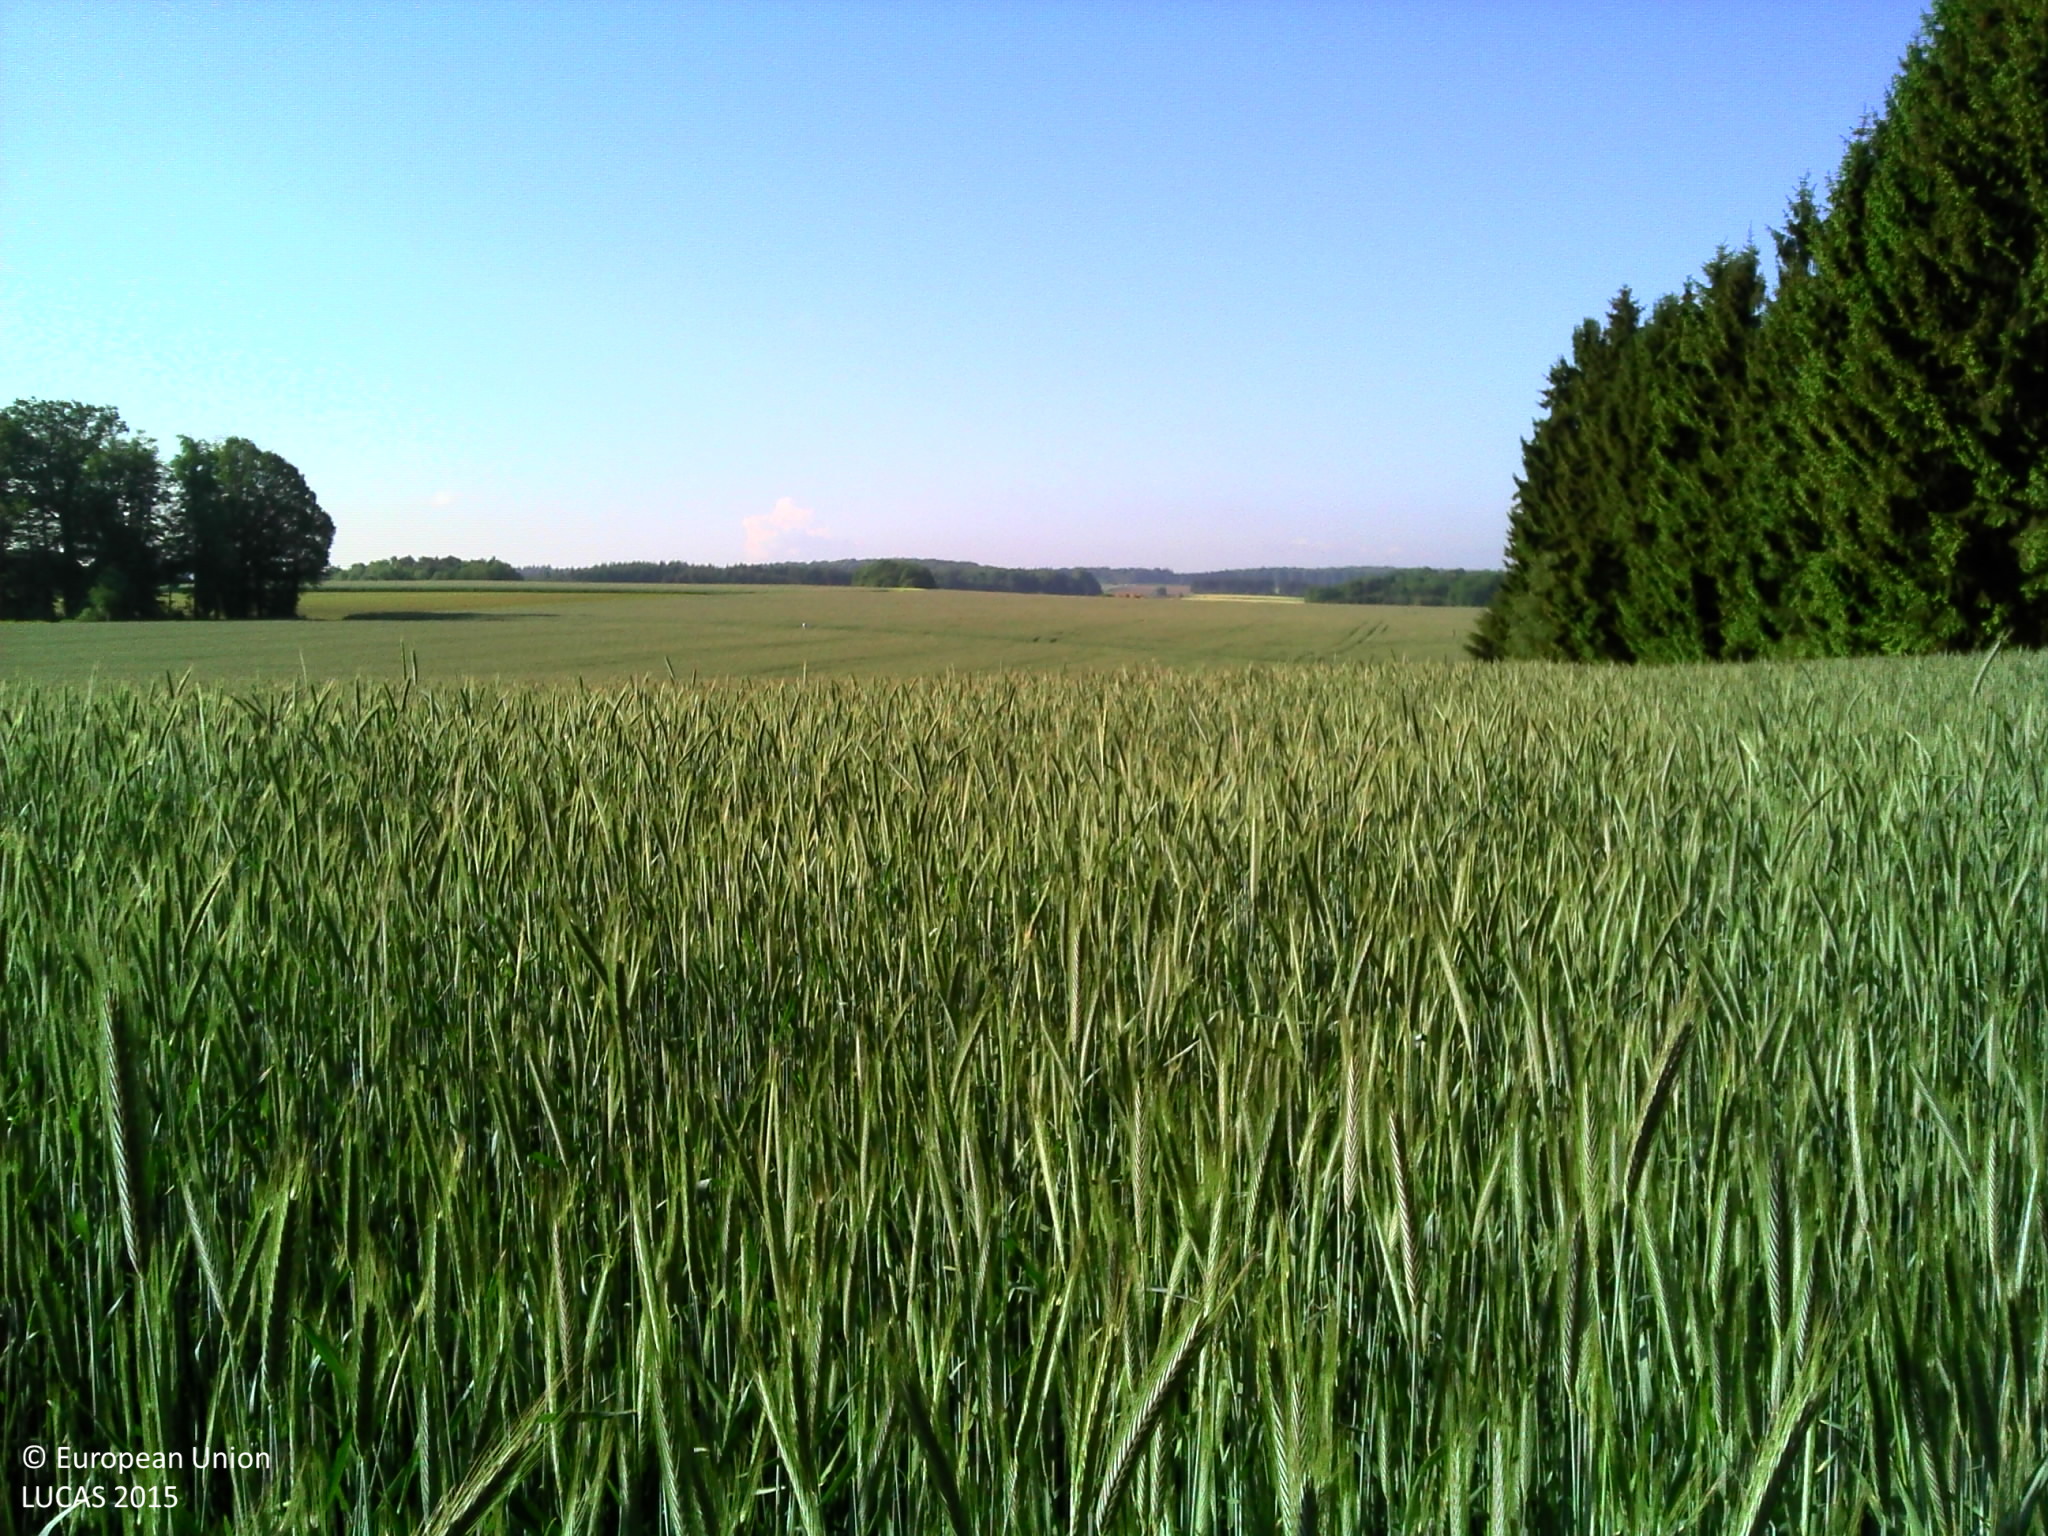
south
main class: Cropland
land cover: Triticale
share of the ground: > 75 %
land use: Agriculture (excluding fallow land and kitchen gardens)
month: May
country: LU
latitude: 49.7036
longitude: 6.1031
